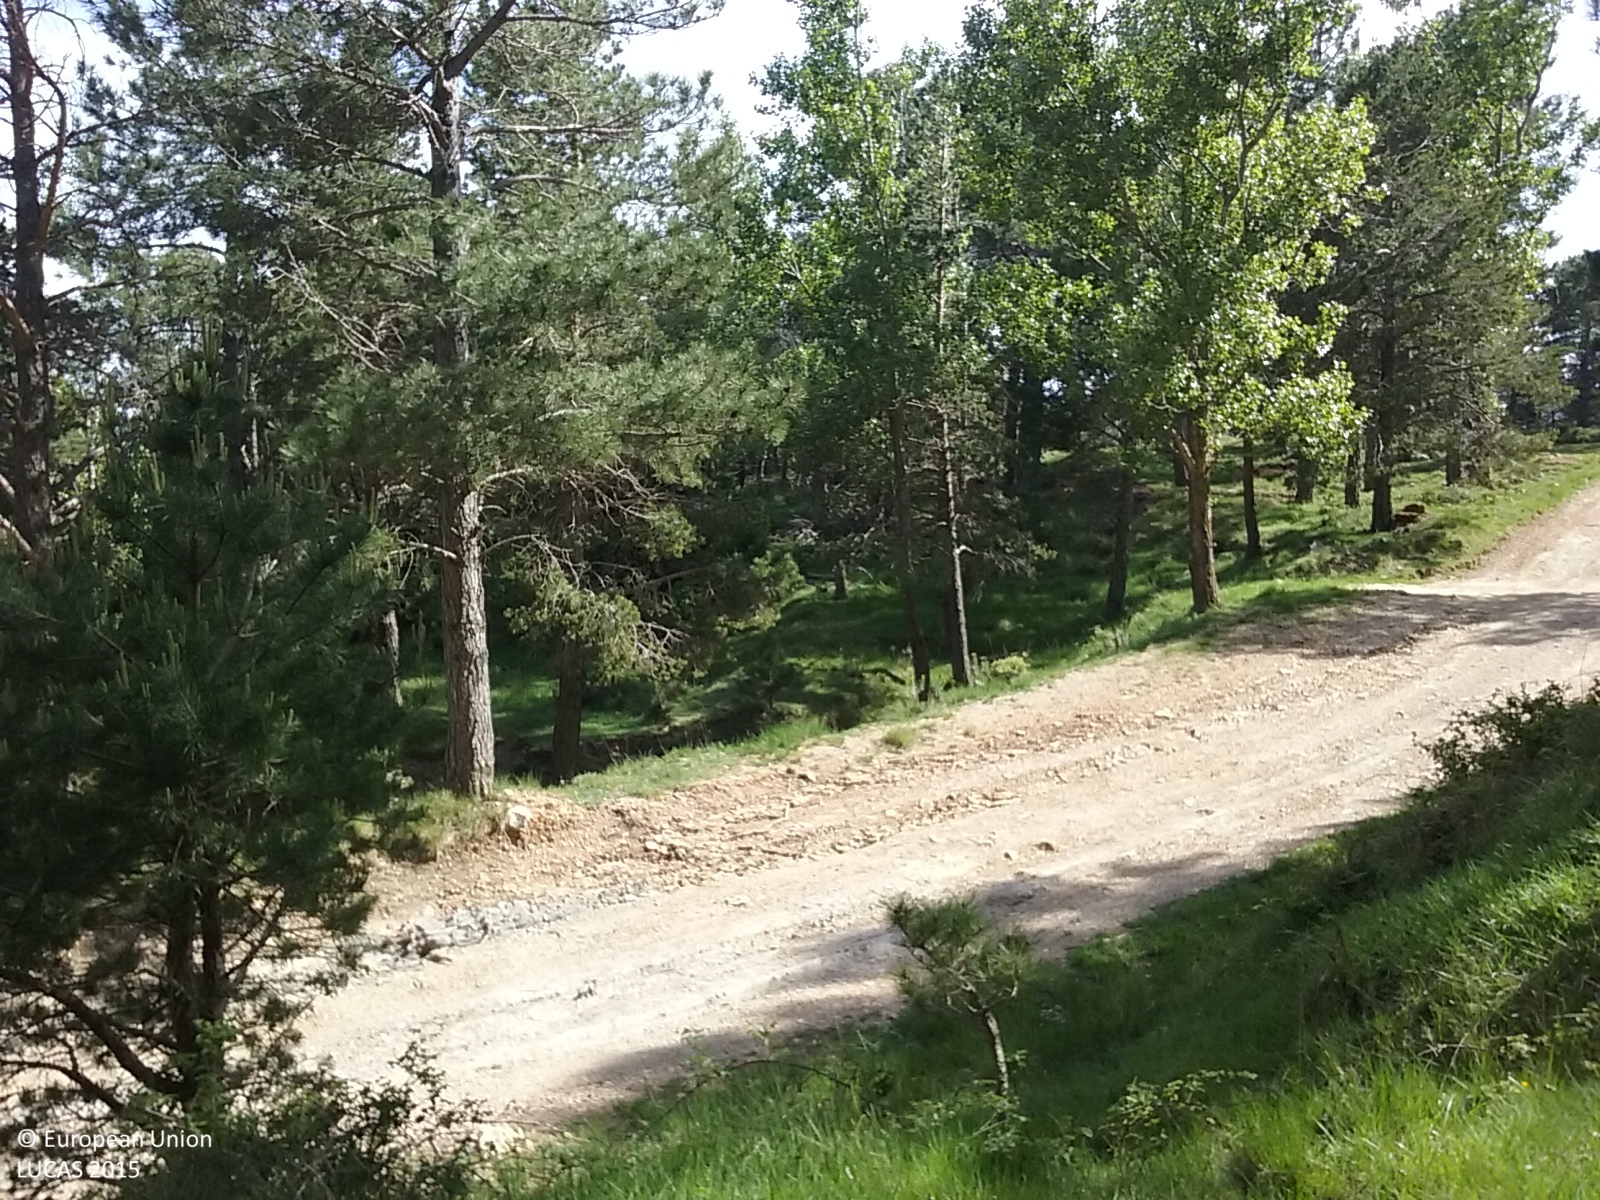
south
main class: Woodland
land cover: Pine dominated coniferous woodland
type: coniferous forest of the mediterranean region
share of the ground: > 75 %
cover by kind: coniferous forest trees 85 %, broadleaved forest trees 5 %, unconsolidated bare surface 5 %
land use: Forestry
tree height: > 5 m
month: May
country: ES
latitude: 40.7678
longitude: 0.2905
